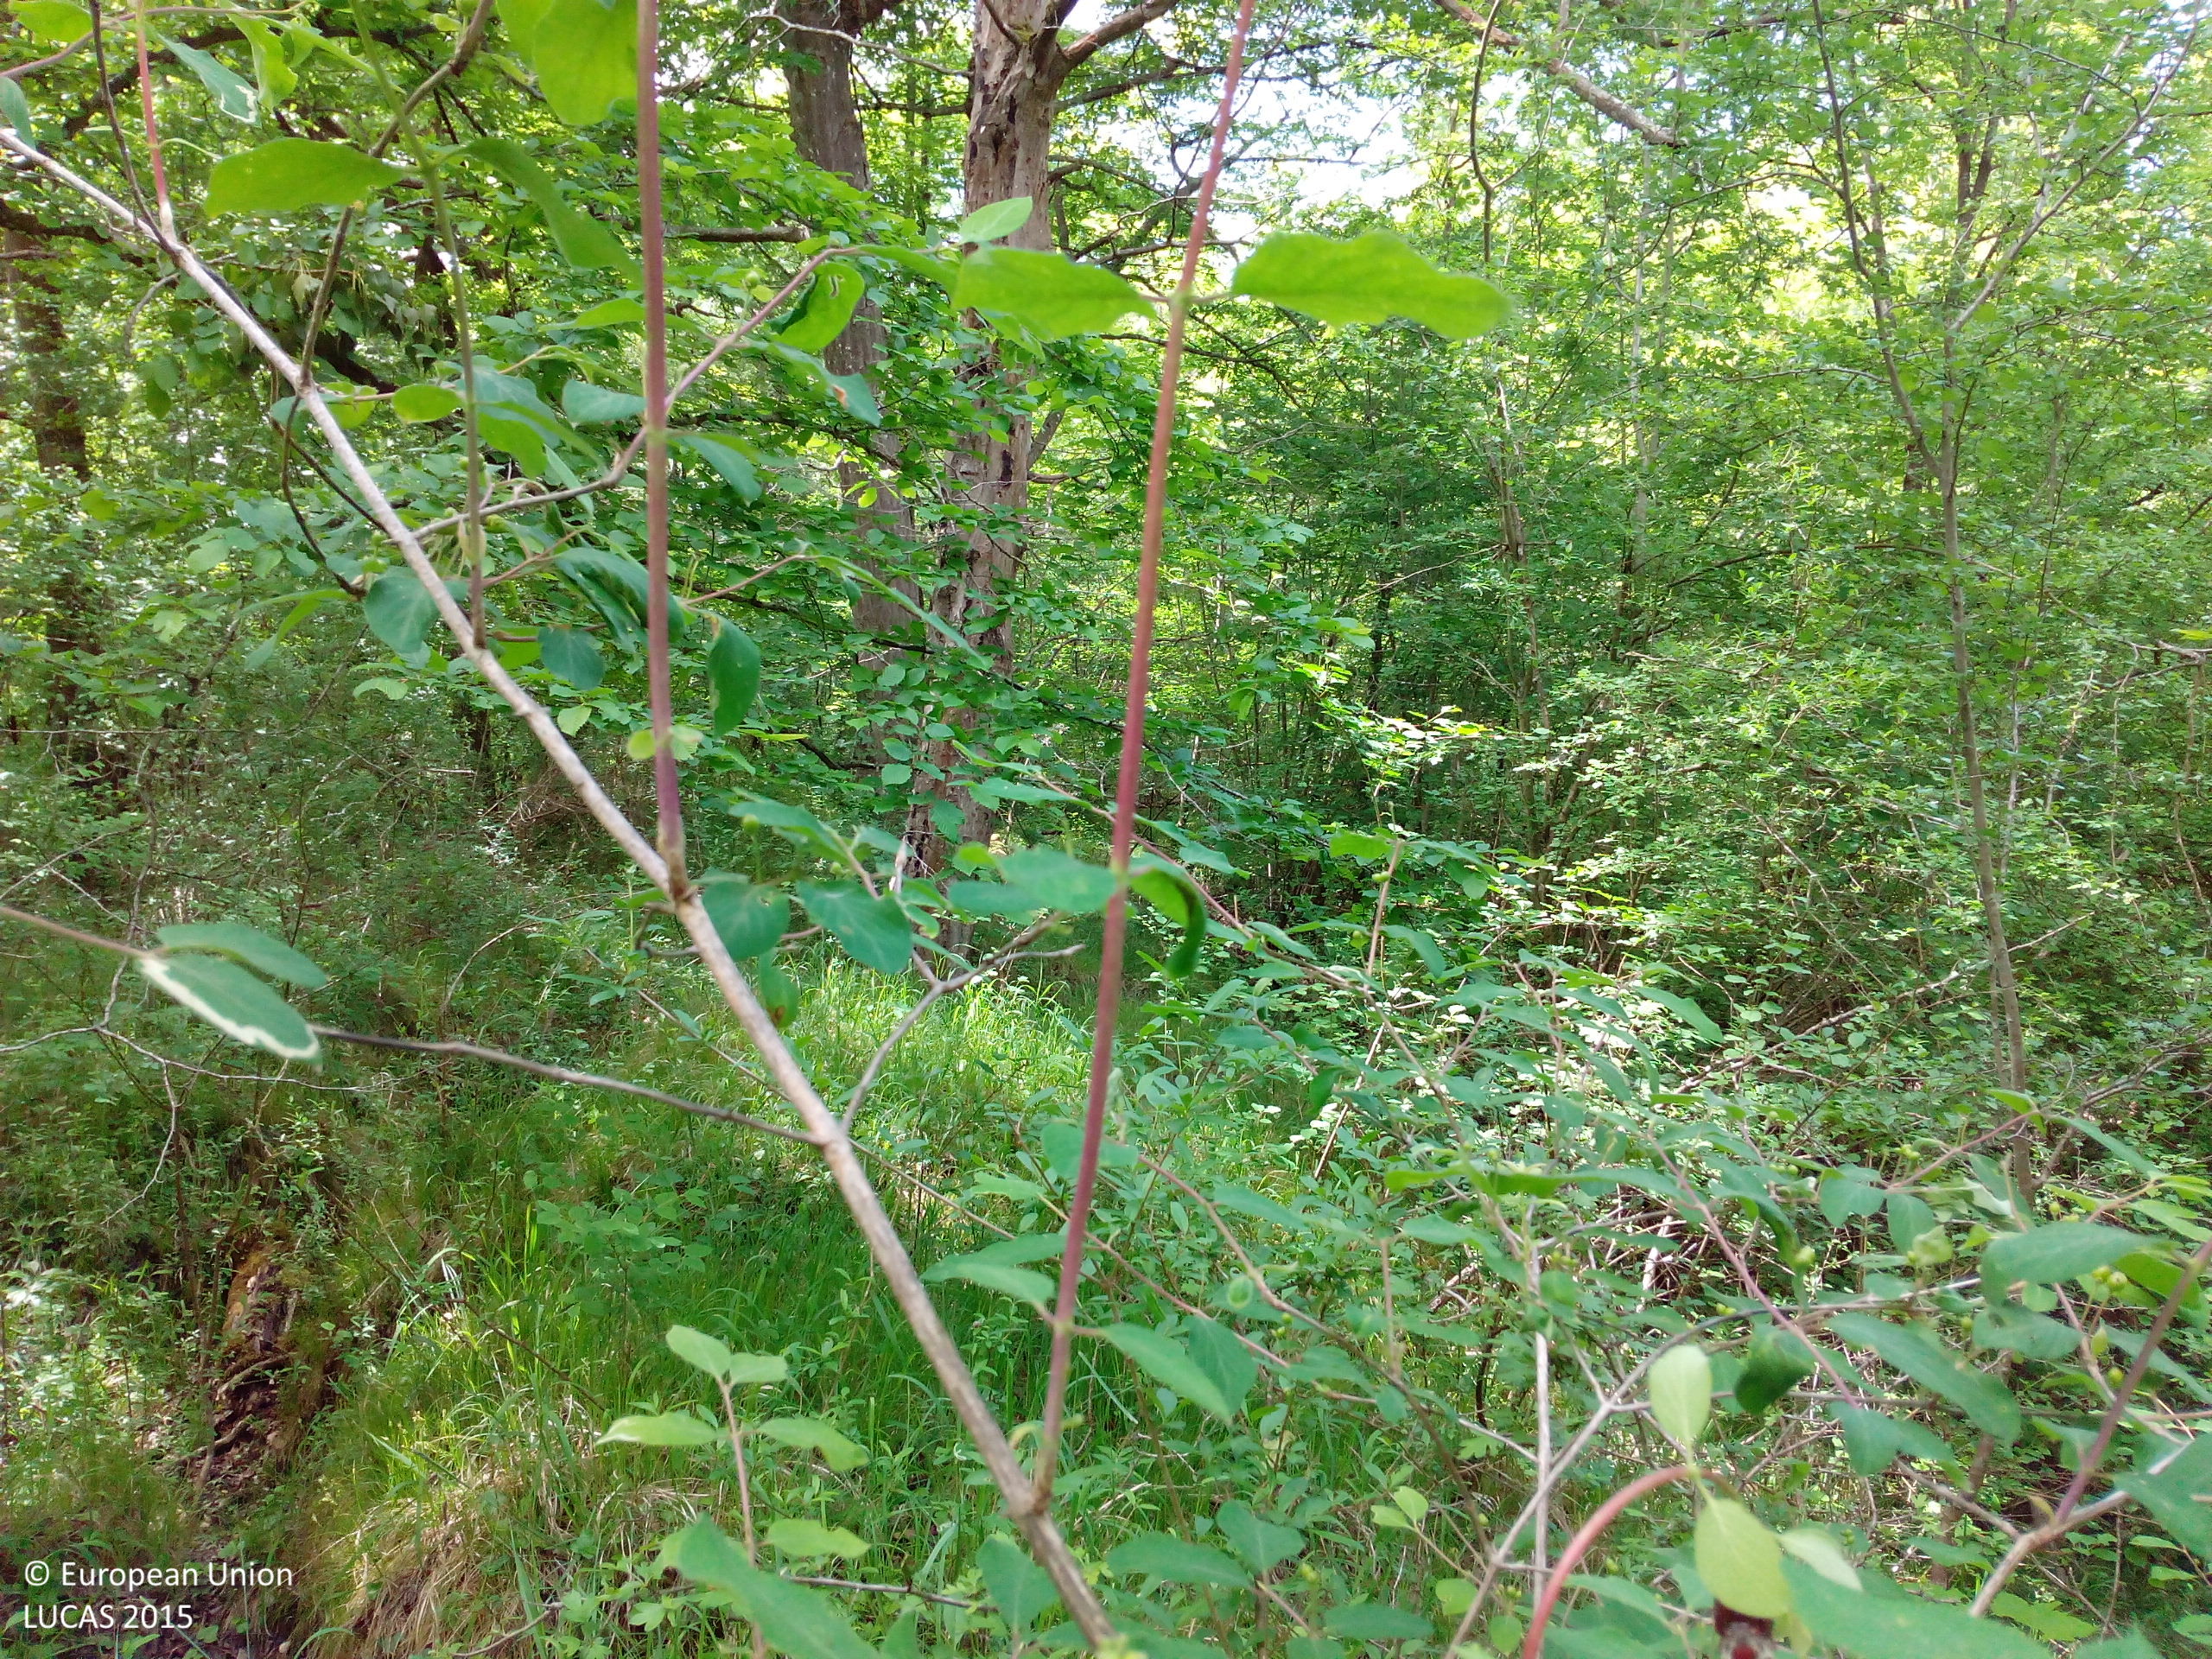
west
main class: Woodland
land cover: Broadleaved woodland
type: floodplain forest
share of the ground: > 75 %
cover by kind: broadleaved forest trees 85 %, shrubs 10 %, herbaceous plants 5 %
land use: Forestry
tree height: > 5 m
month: May
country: DE
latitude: 47.9455
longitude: 7.6047
